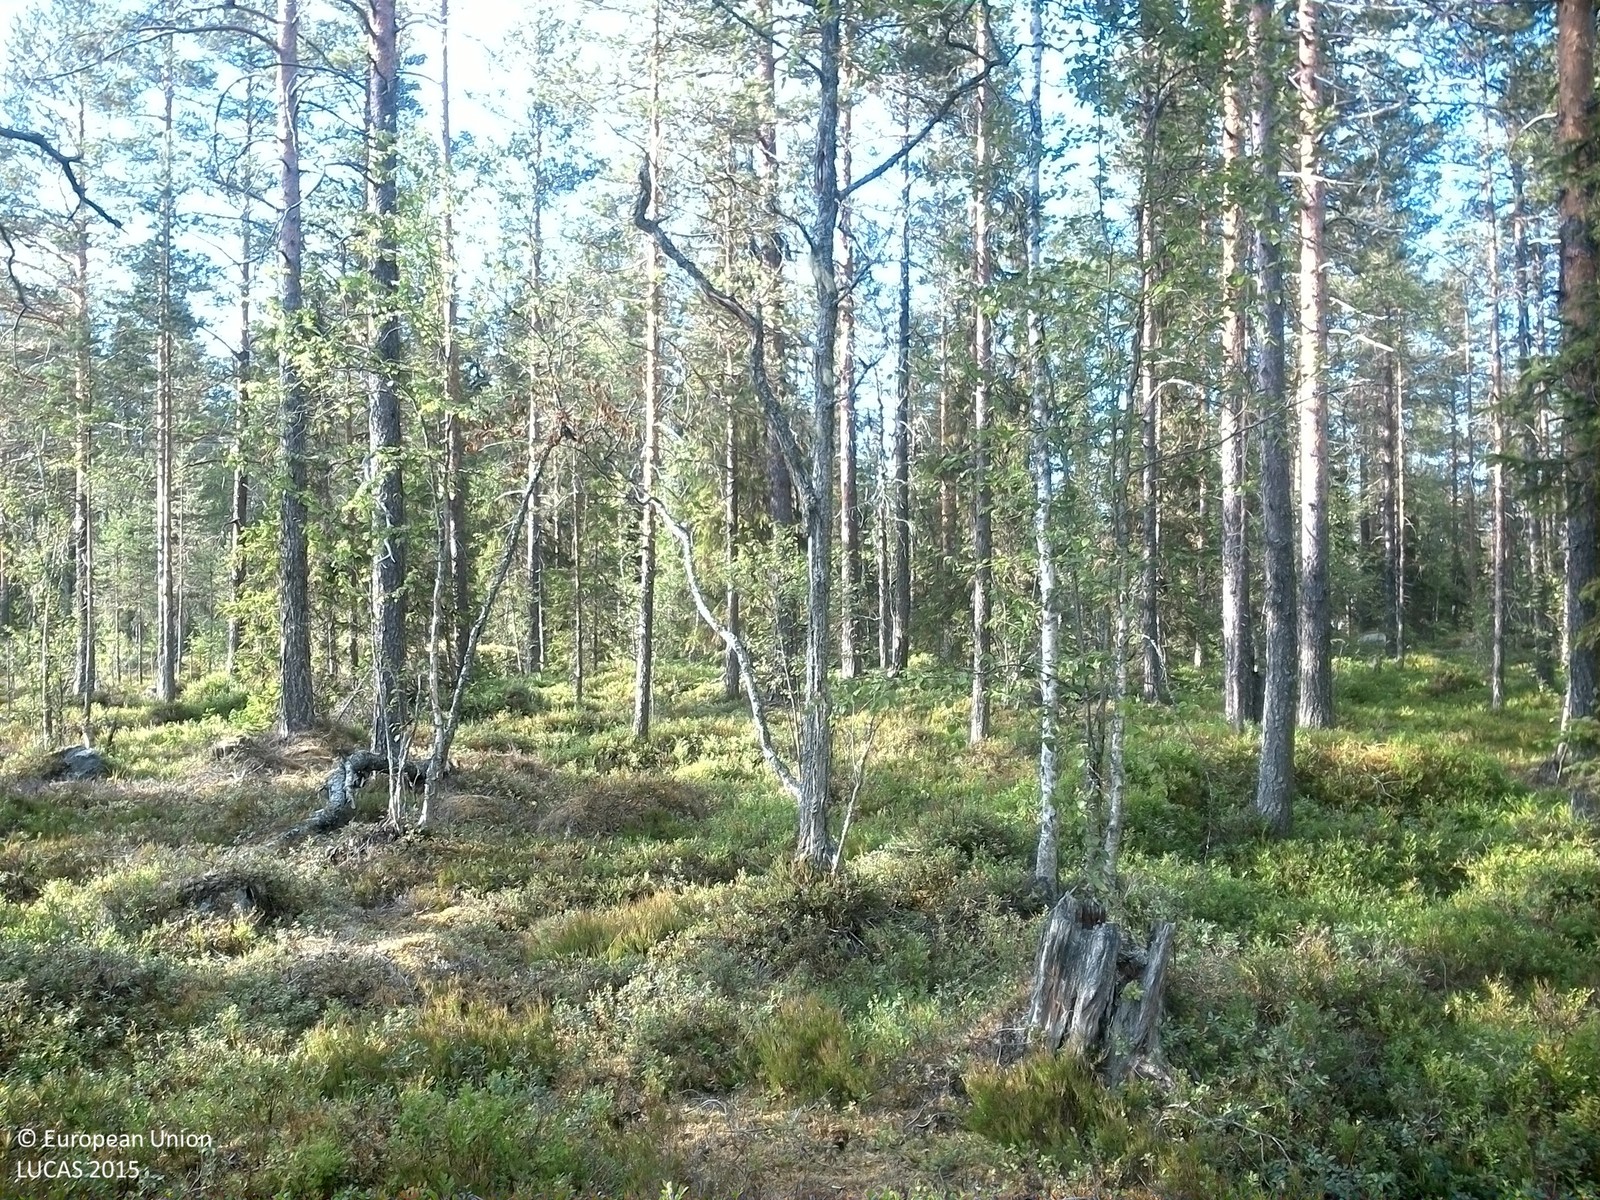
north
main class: Woodland
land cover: Pine dominated mixed woodland
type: boreal forest
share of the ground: 25 - 50 %
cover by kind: shrubs 40 %, coniferous forest trees 35 %, broadleaved forest trees 15 %, herbaceous plants 5 %, lichens and mosses 5 %
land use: Forestry
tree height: > 5 m
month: August
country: SE
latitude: 62.8503
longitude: 16.9508
